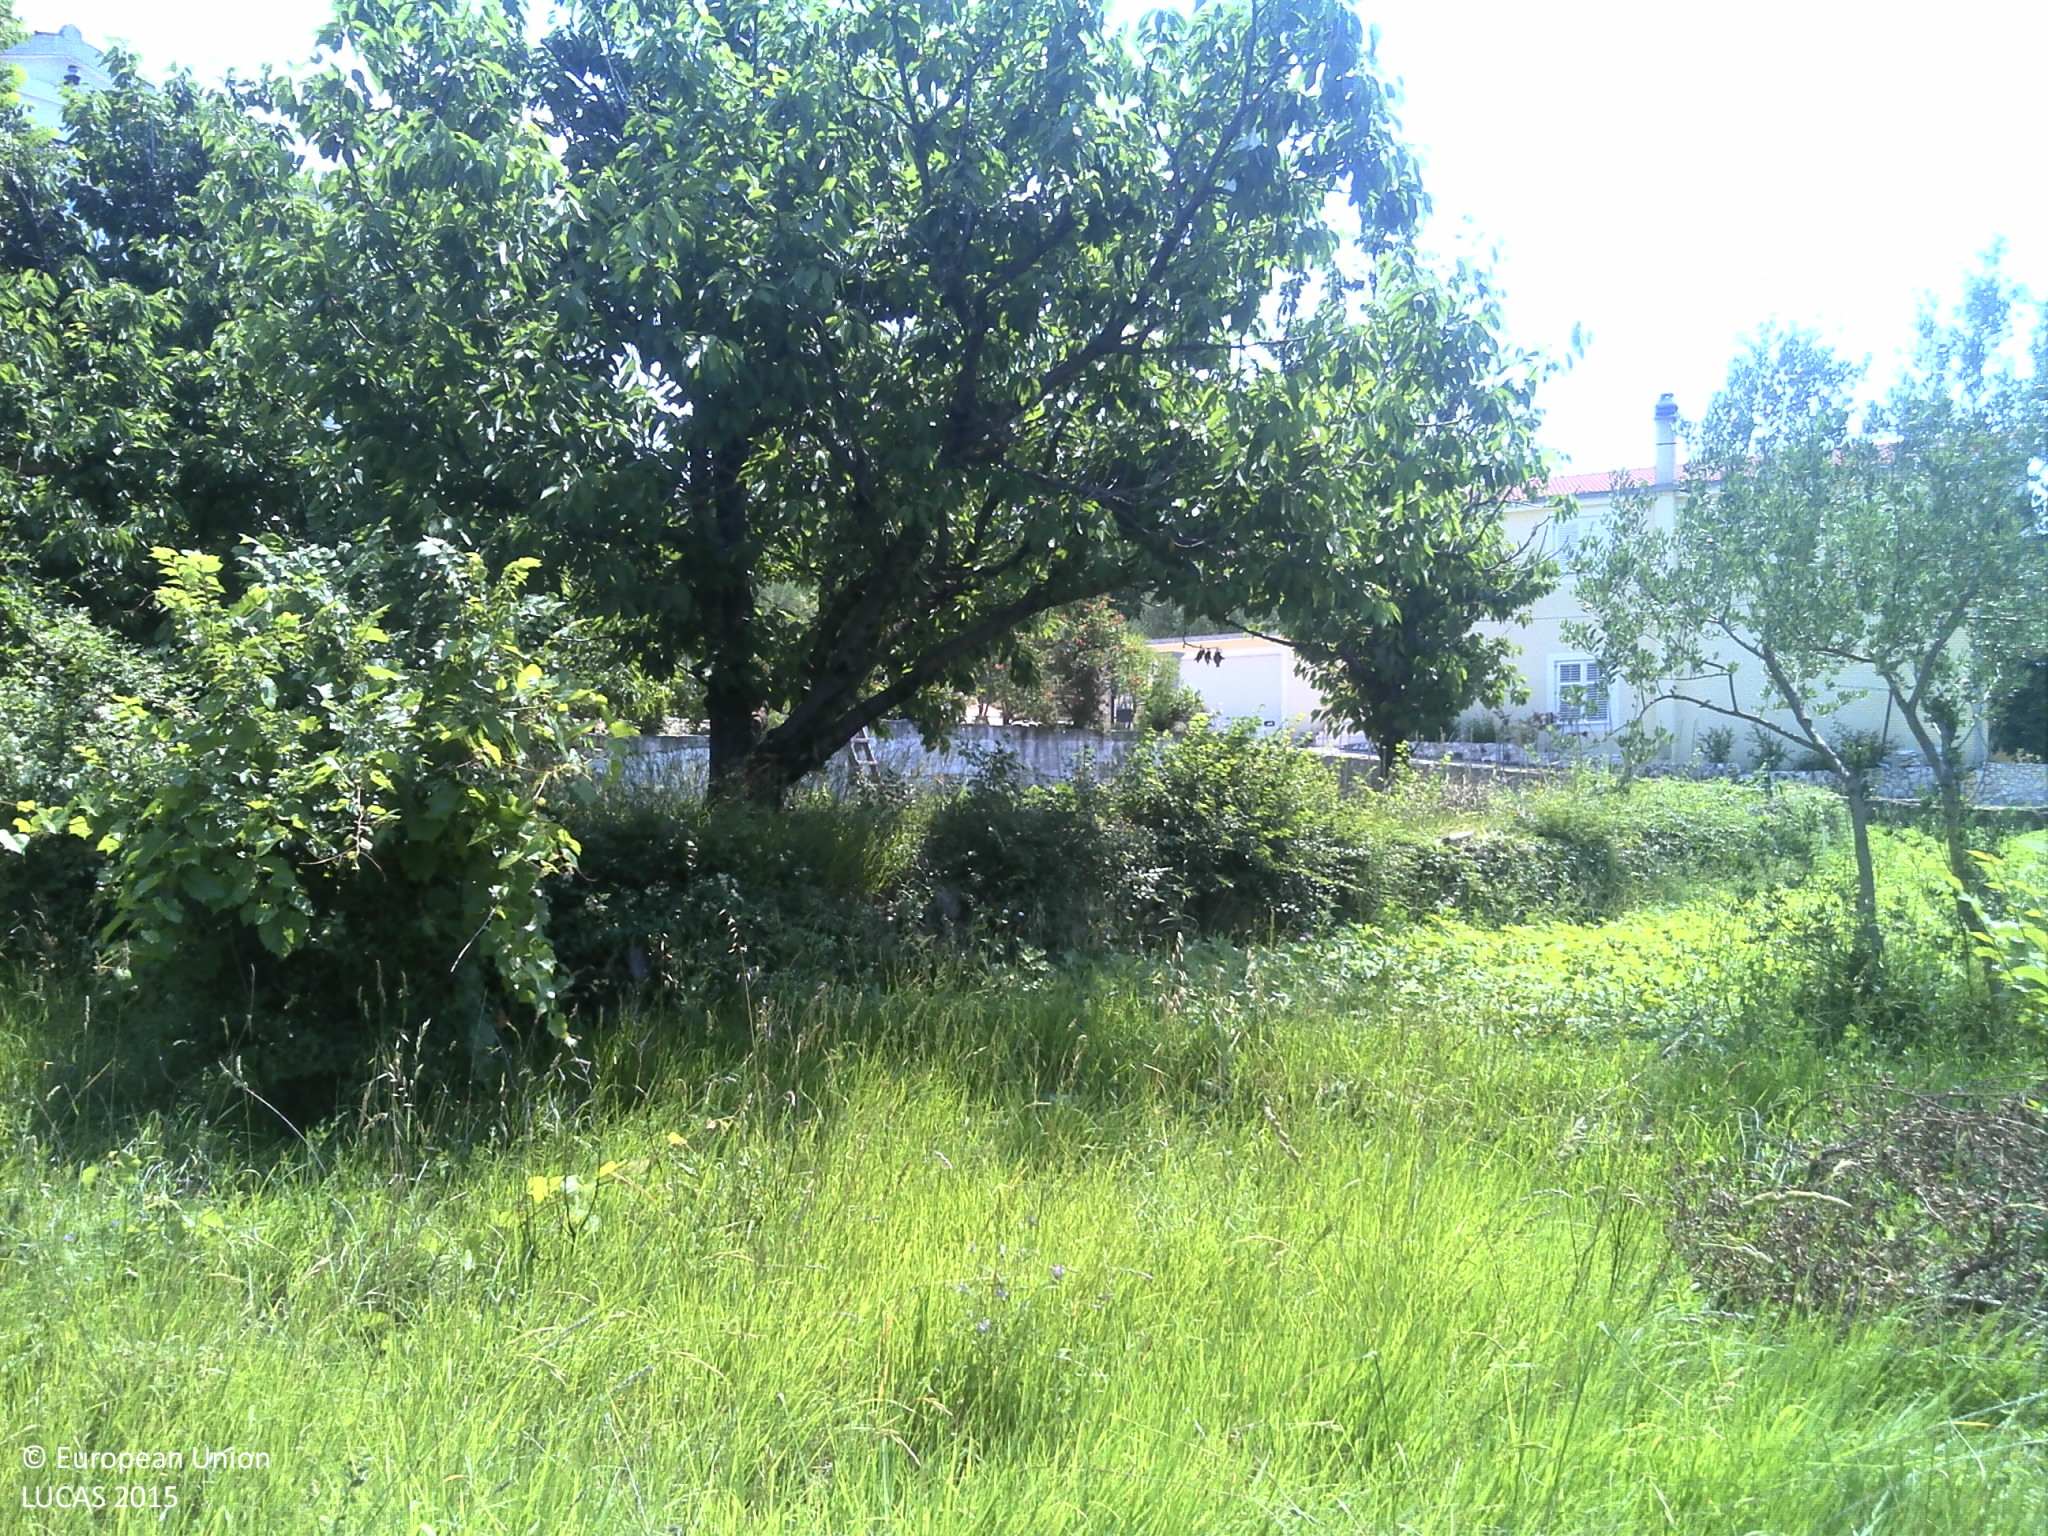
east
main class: Grassland
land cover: Grassland with sparse tree/shrub cover
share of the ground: > 75 %
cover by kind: herbaceous plants 85 %, shrubs 10 %, broadleaved forest trees 5 %
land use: Agriculture (excluding fallow land and kitchen gardens)
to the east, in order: Grassland with sparse tree/shrub cover; Olive groves; Arable land (only in case pi); Artificial constructions in urban areas; Olive groves; Dry stone walls; Grassland with sparse tree/shrub cover; Dry stone walls; Grassland with sparse tree/shrub cover; Dry stone walls; Shrubland with sparse tree cover; Dry stone walls; Shrubland with sparse tree cover; Dry stone walls; Pine dominated coniferous woodland; Dry stone walls; Pine dominated coniferous woodland
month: June
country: HR
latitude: 43.4885
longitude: 16.6063
